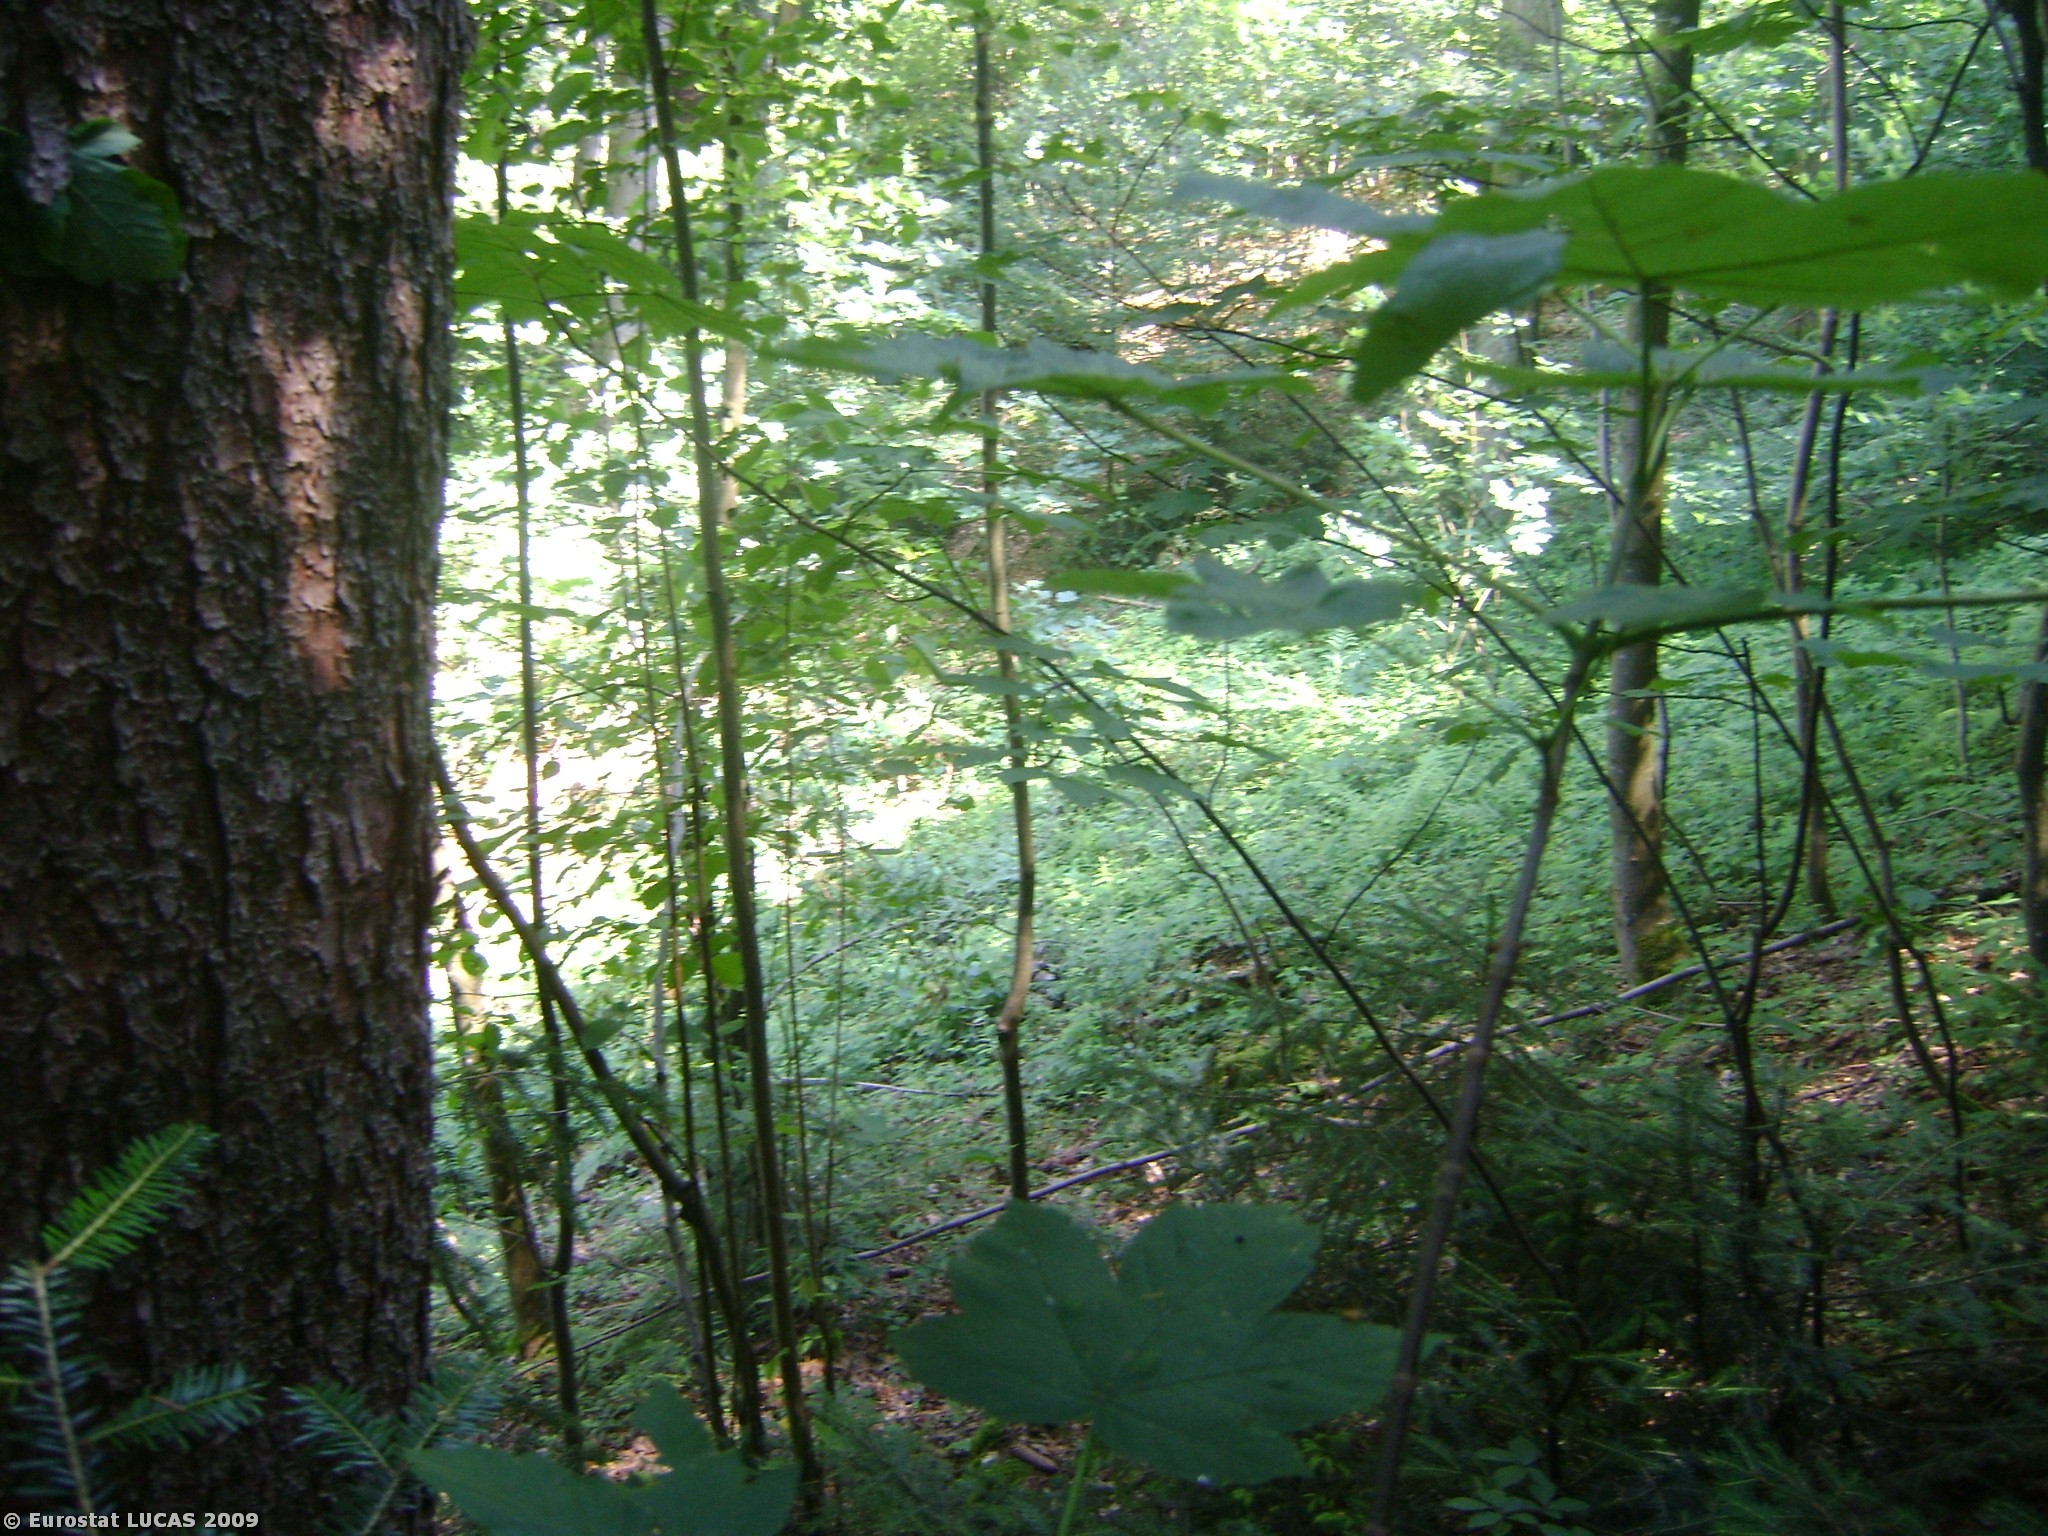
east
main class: Woodland
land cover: Mixed woodland
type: hemiboreal forest and nemoral coniferous forest and mixed broadleaved-coniferous forest
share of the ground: > 75 %
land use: Forestry
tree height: > 5 m
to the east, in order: Mixed woodland; Coniferous woodland; Tracks; Mixed woodland; Fences; Mixed woodland; Fences; Grass margins; Coniferous woodland
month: June
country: AT
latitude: 48.1196
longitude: 13.3172
